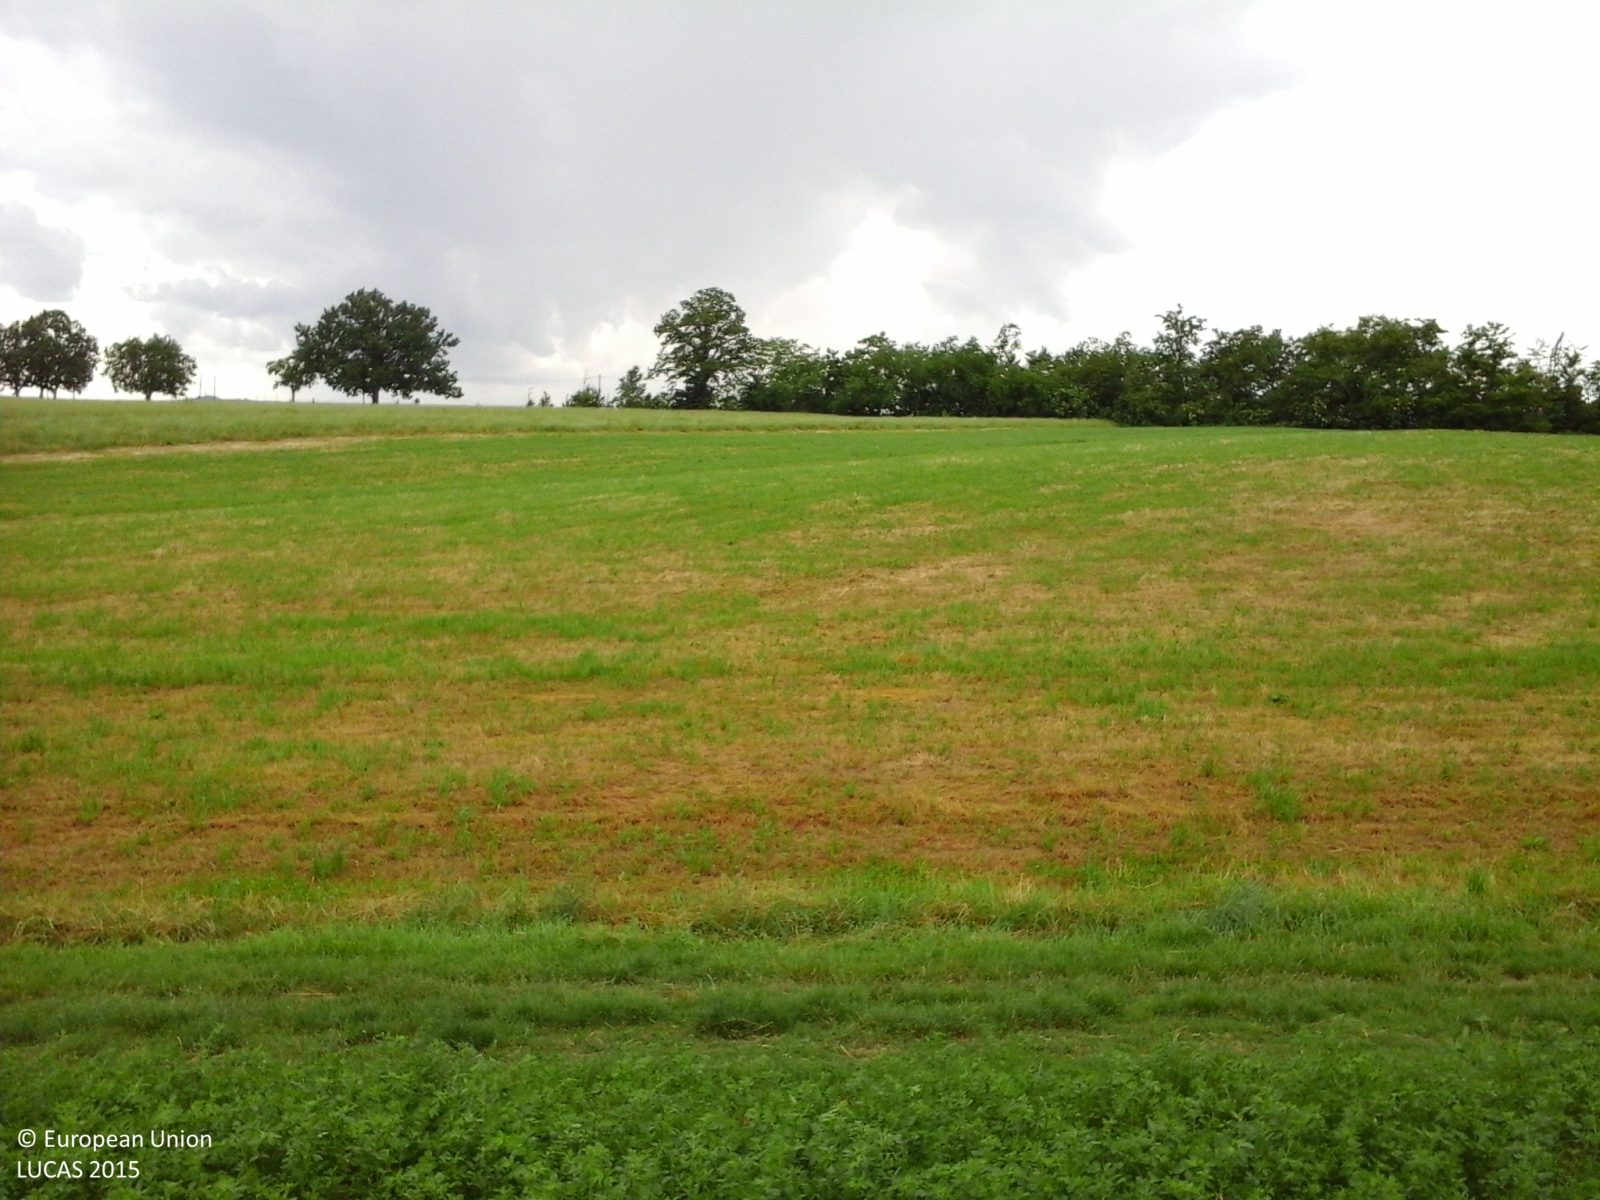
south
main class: Cropland
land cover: Barley
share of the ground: > 75 %
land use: Agriculture (excluding fallow land and kitchen gardens)
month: May
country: IT
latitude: 44.6189
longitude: 10.6665
